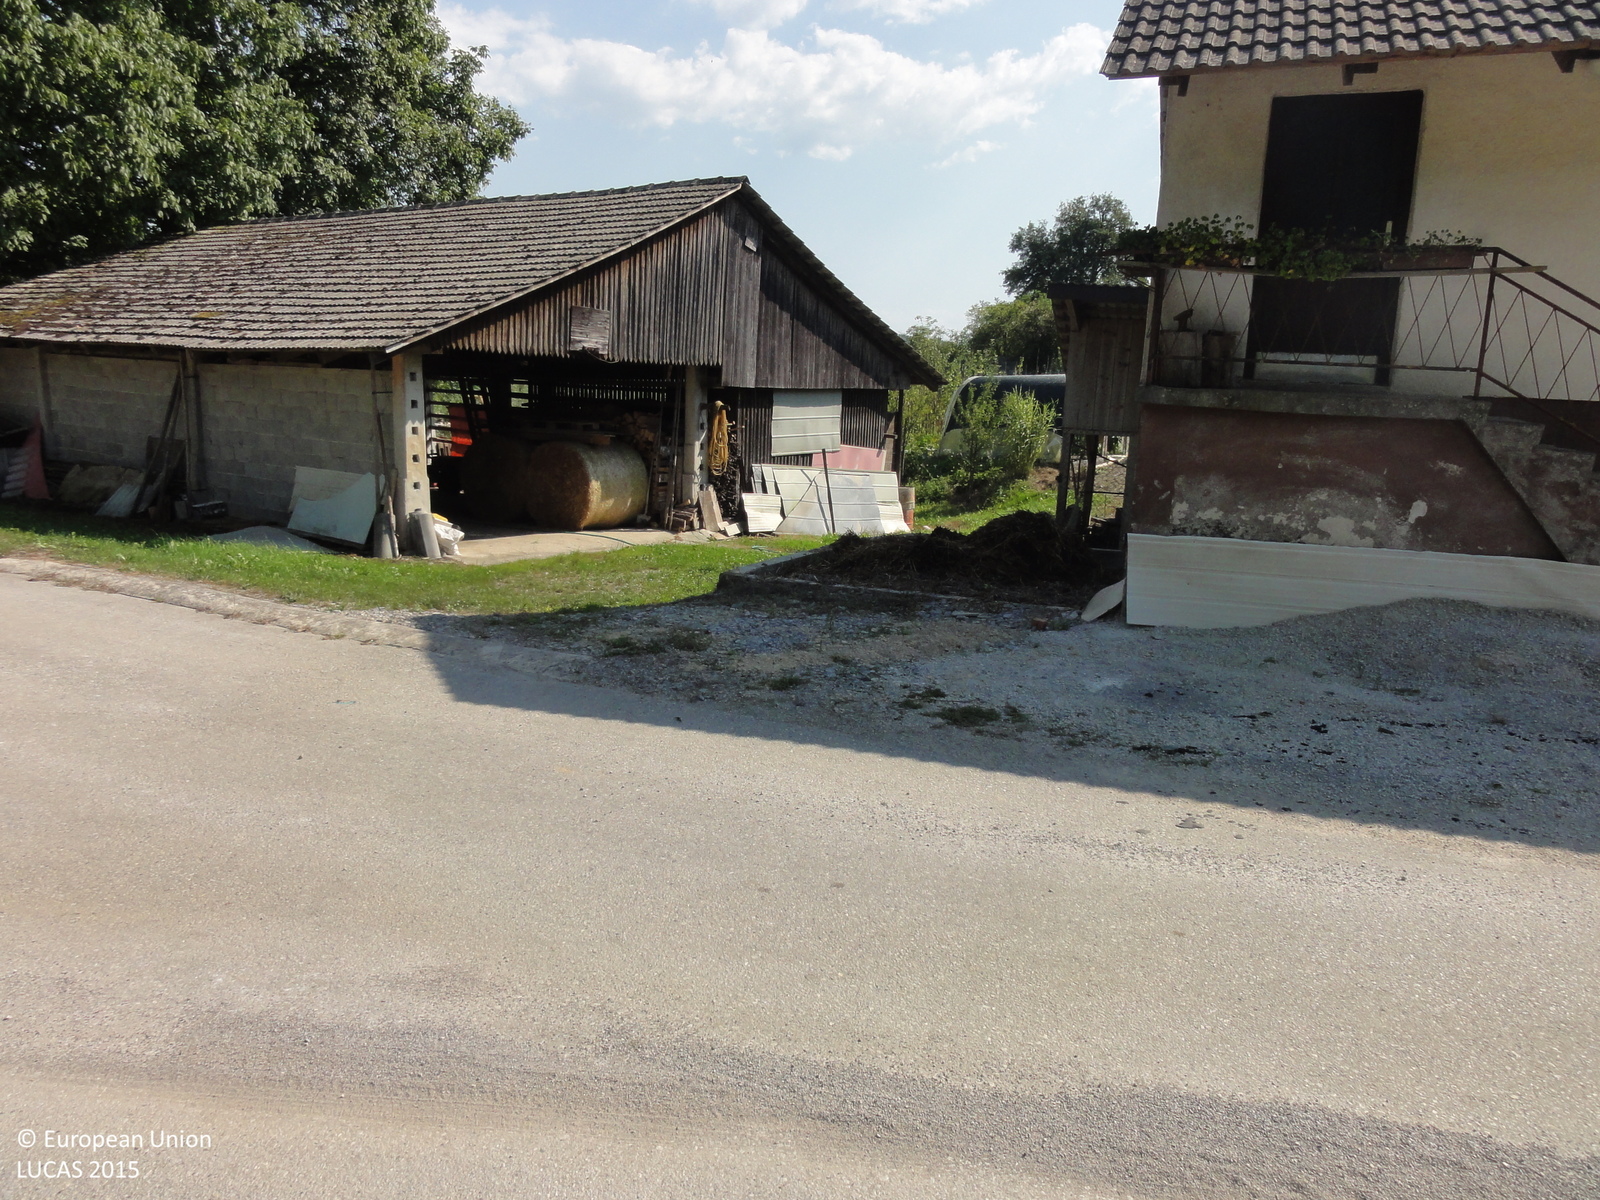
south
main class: Grassland
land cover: Grassland without tree/shrub cover
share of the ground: 50 - 75 %
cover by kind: herbaceous plants 60 %
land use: Residential
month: August
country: SI
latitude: 45.9065
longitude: 15.0627
